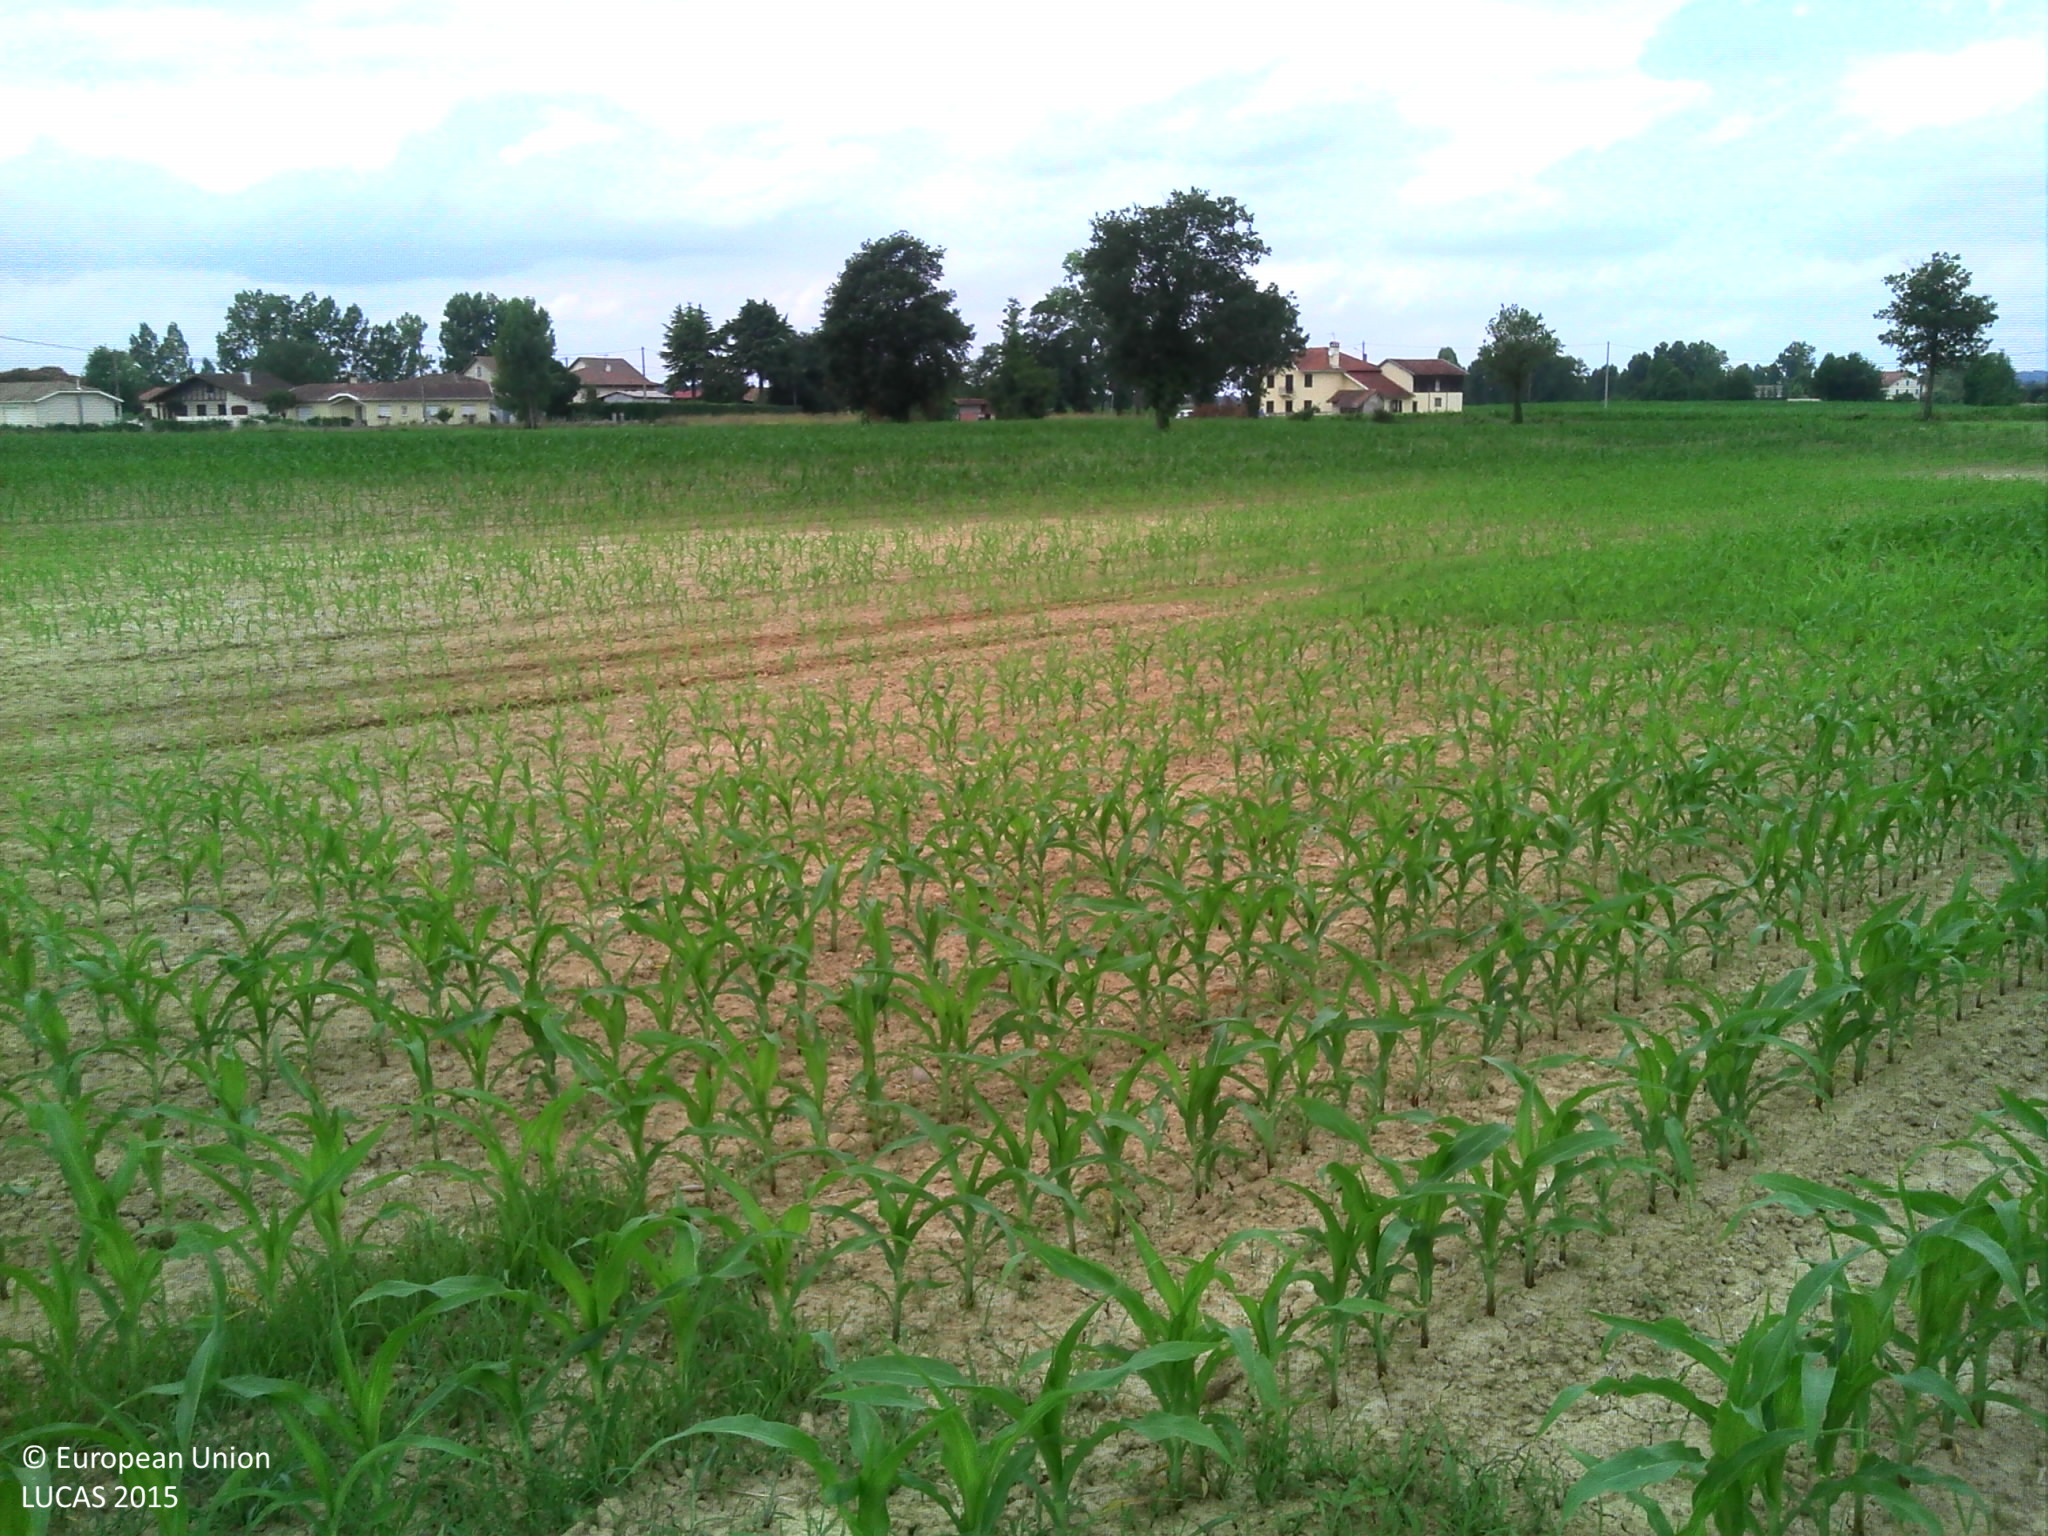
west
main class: Cropland
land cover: Maize
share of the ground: 50 - 75 %
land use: Agriculture (excluding fallow land and kitchen gardens)
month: July
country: FR
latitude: 43.6235
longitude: -0.7818
